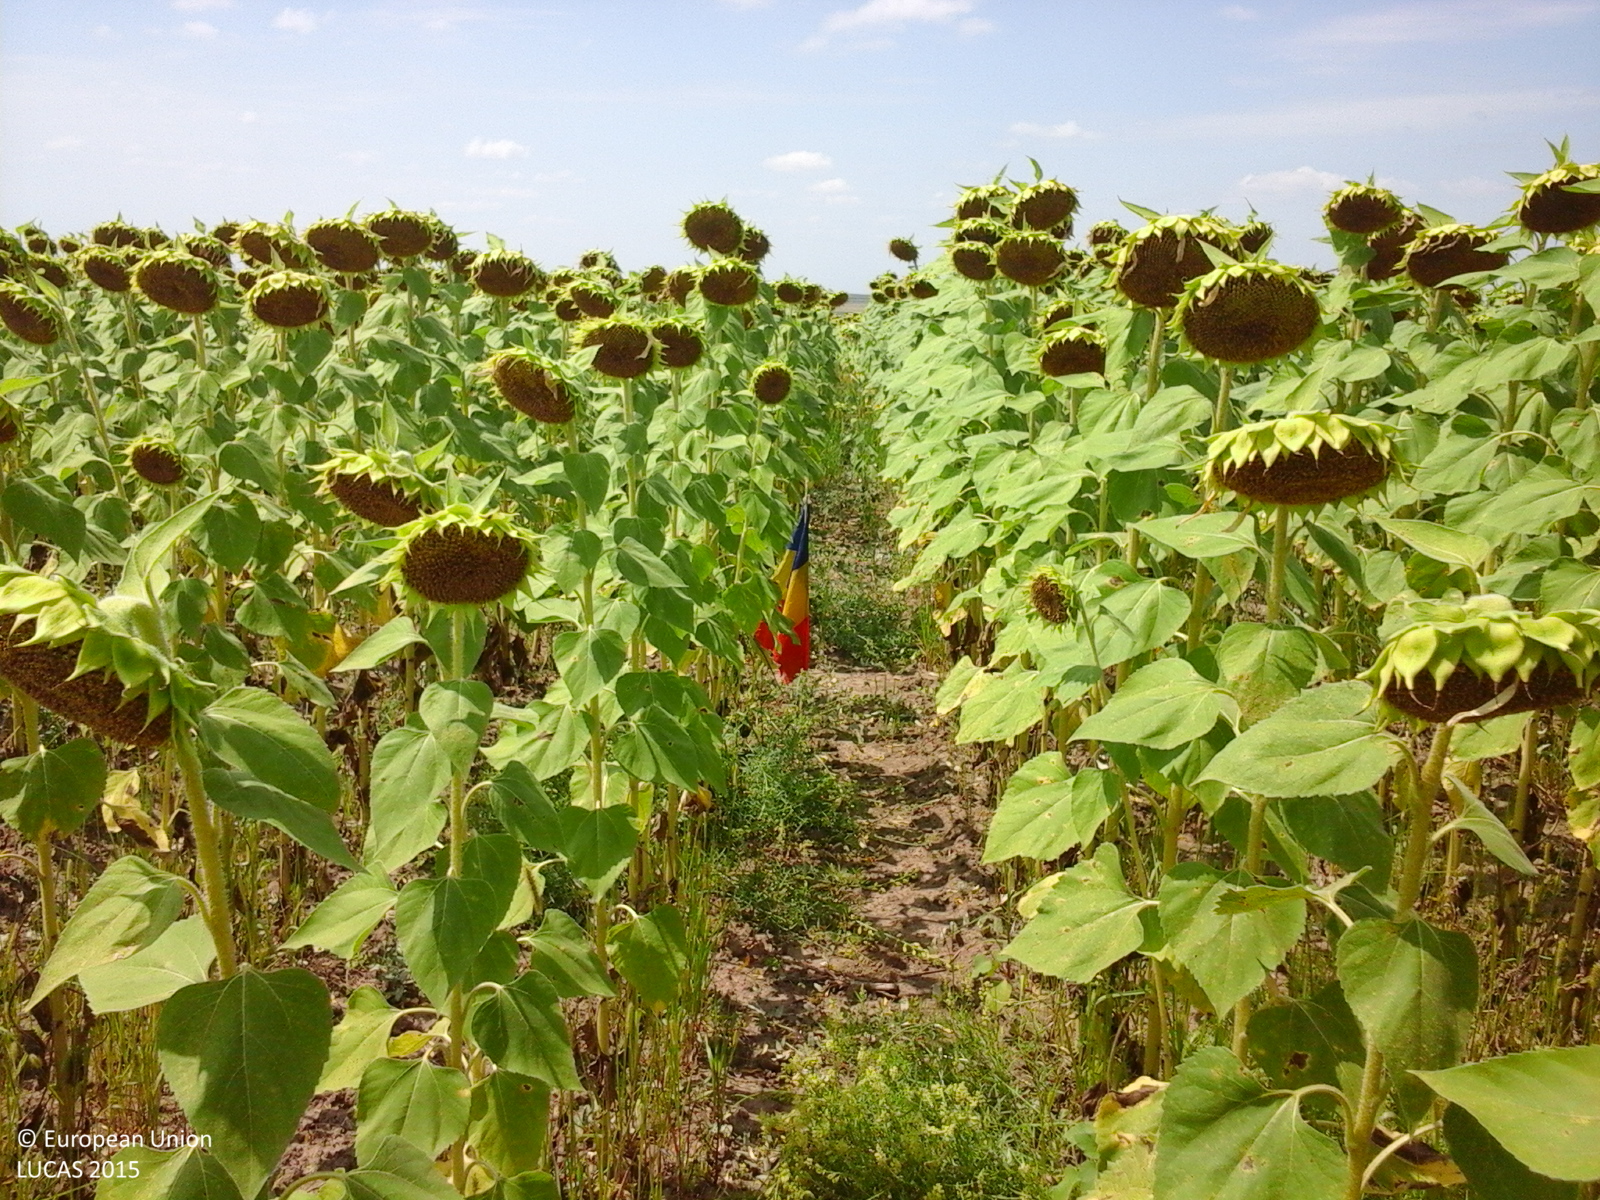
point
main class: Cropland
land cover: Sunflower
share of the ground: > 75 %
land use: Agriculture (excluding fallow land and kitchen gardens)
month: August
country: RO
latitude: 44.8076
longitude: 28.2105
